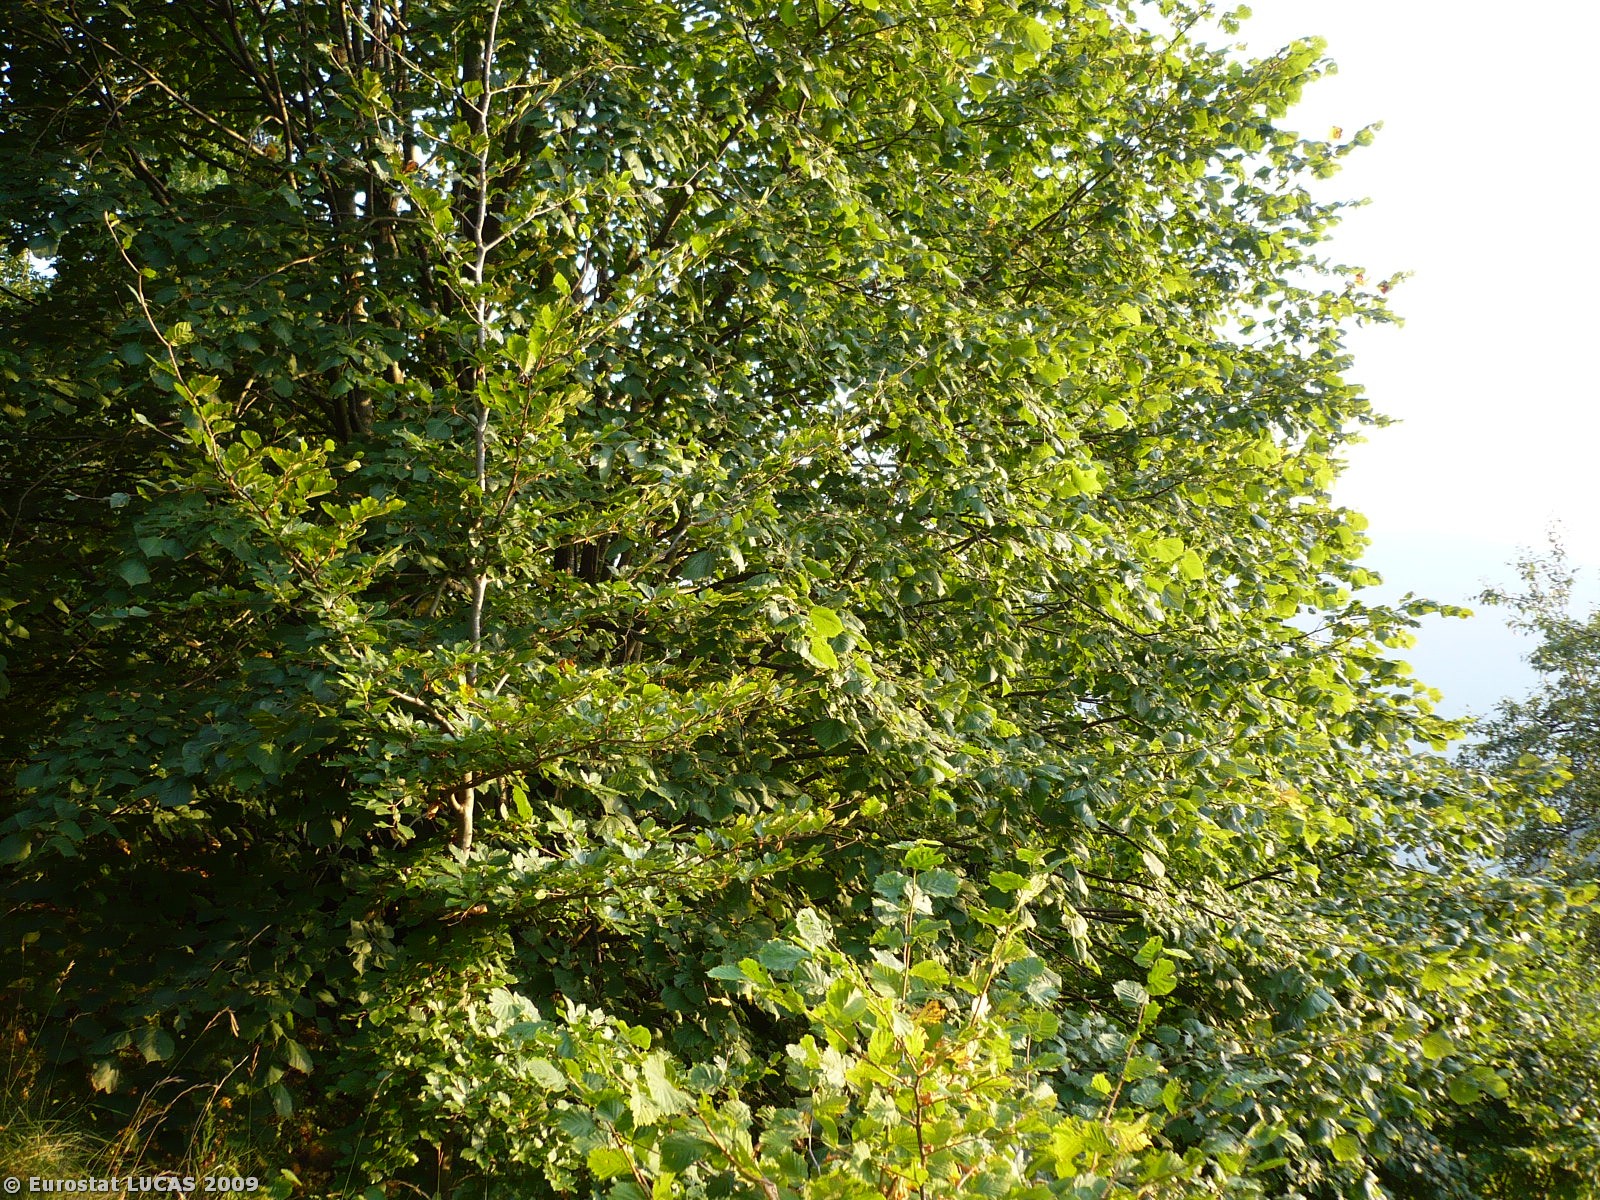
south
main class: Grassland
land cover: Grassland with sparse tree/shrub cover
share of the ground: > 75 %
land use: Fallow land
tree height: > 5 m
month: August
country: SI
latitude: 46.2343
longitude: 13.6663
